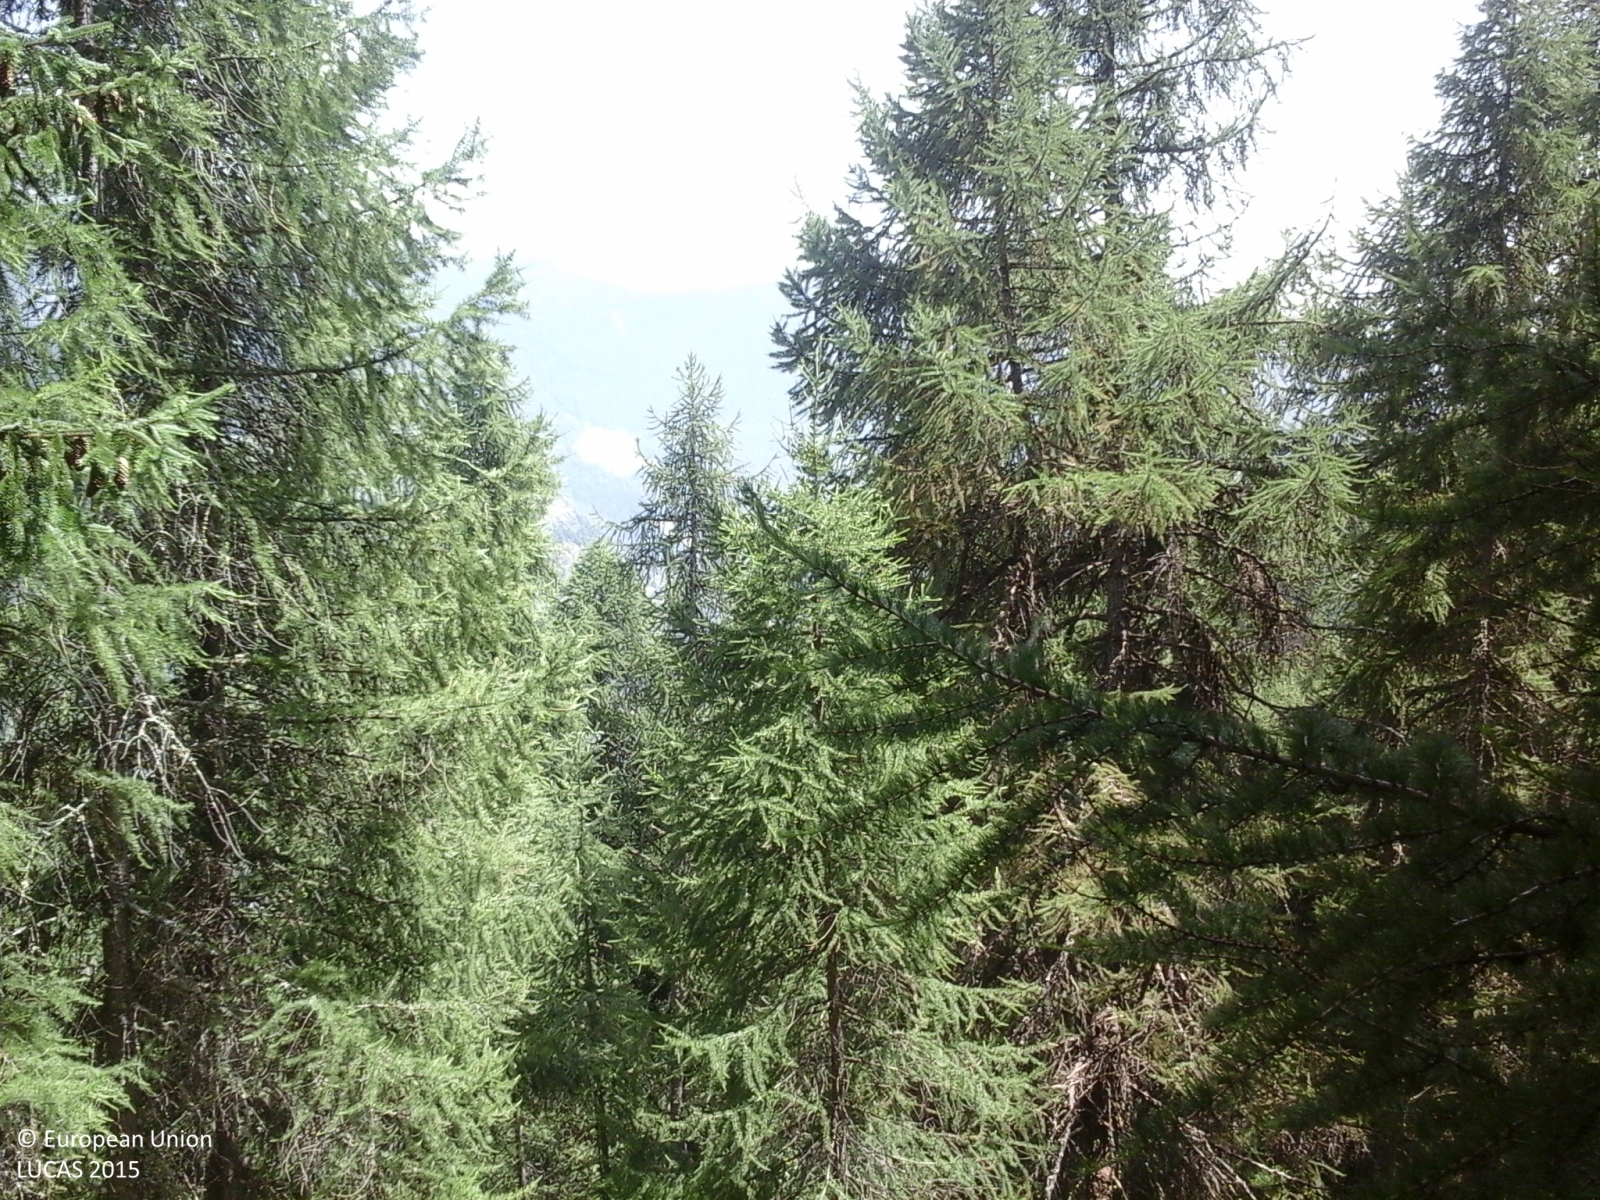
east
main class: Woodland
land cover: Other coniferous woodland
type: alpine coniferous forest
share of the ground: > 75 %
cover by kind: coniferous forest trees 100 %
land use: Forestry
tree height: < 5 m
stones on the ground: < 10 %
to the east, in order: Other coniferous woodland
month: July
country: IT
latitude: 45.8190
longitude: 7.5708
